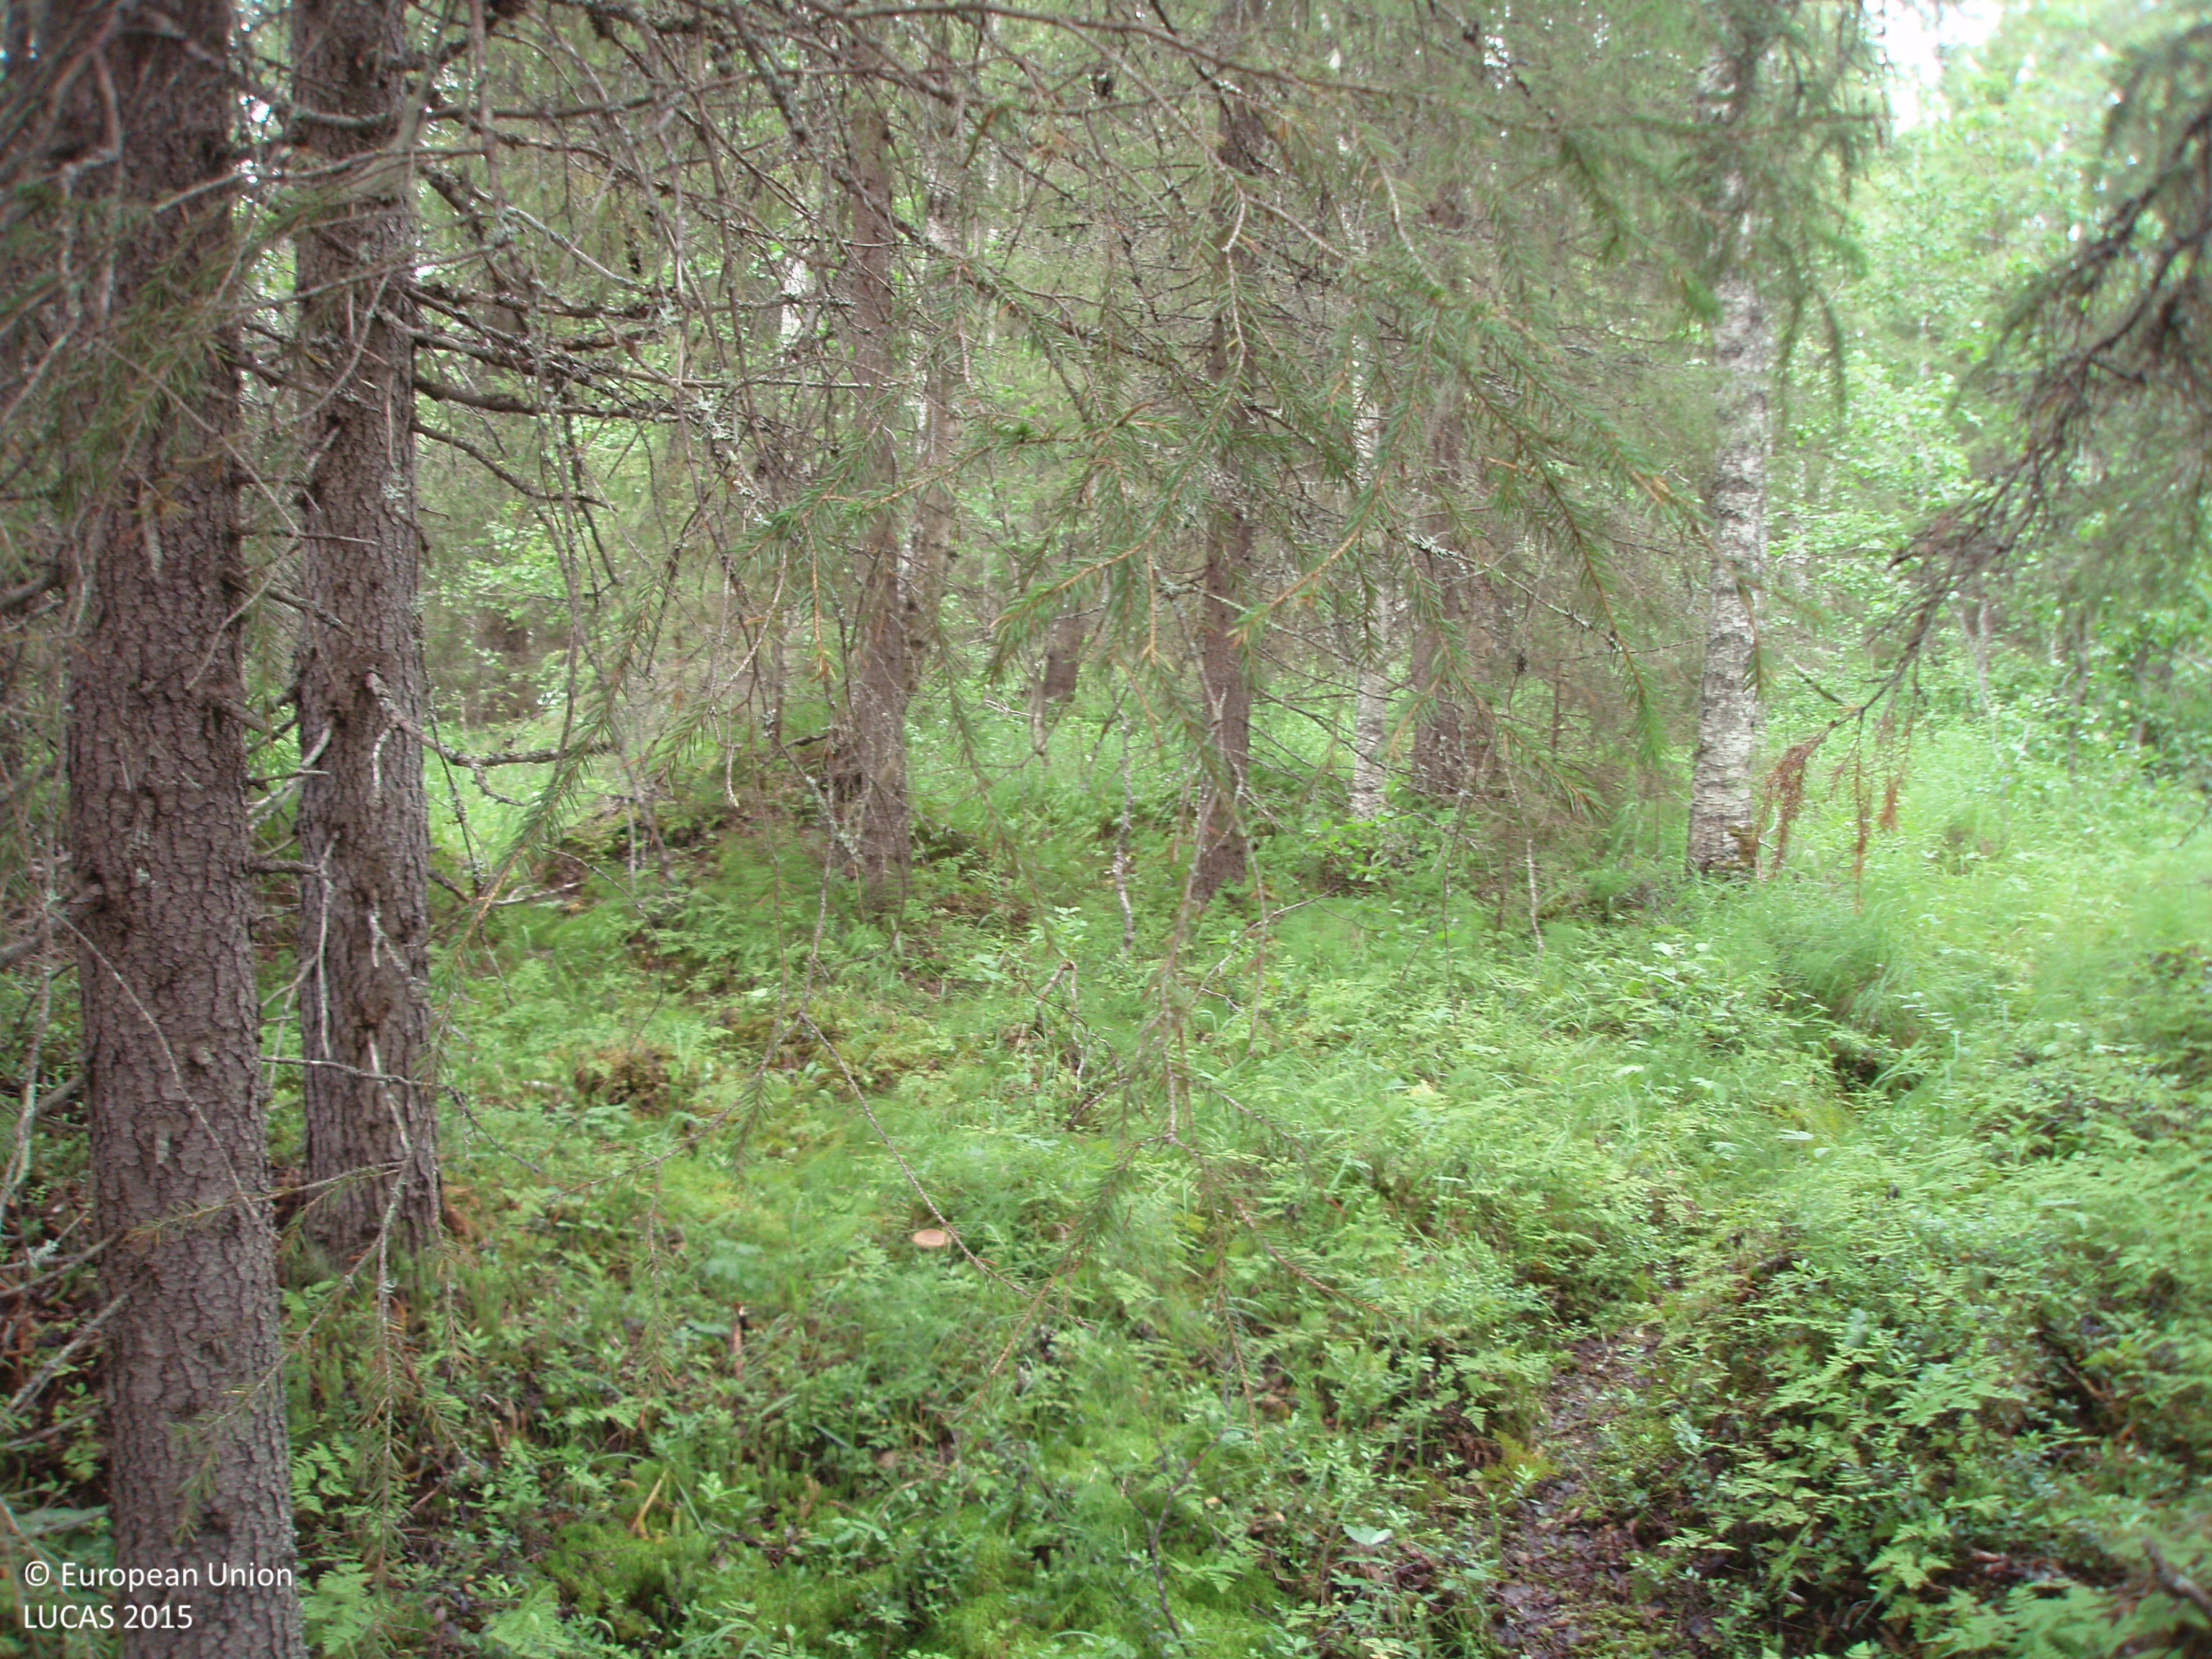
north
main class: Woodland
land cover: Spruce dominated mixed woodland
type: boreal forest
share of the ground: > 75 %
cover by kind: coniferous forest trees 45 %, broadleaved forest trees 40 %, shrubs 15 %
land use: Forestry
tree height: > 5 m
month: July
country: FI
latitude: 65.6612
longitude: 27.7258
